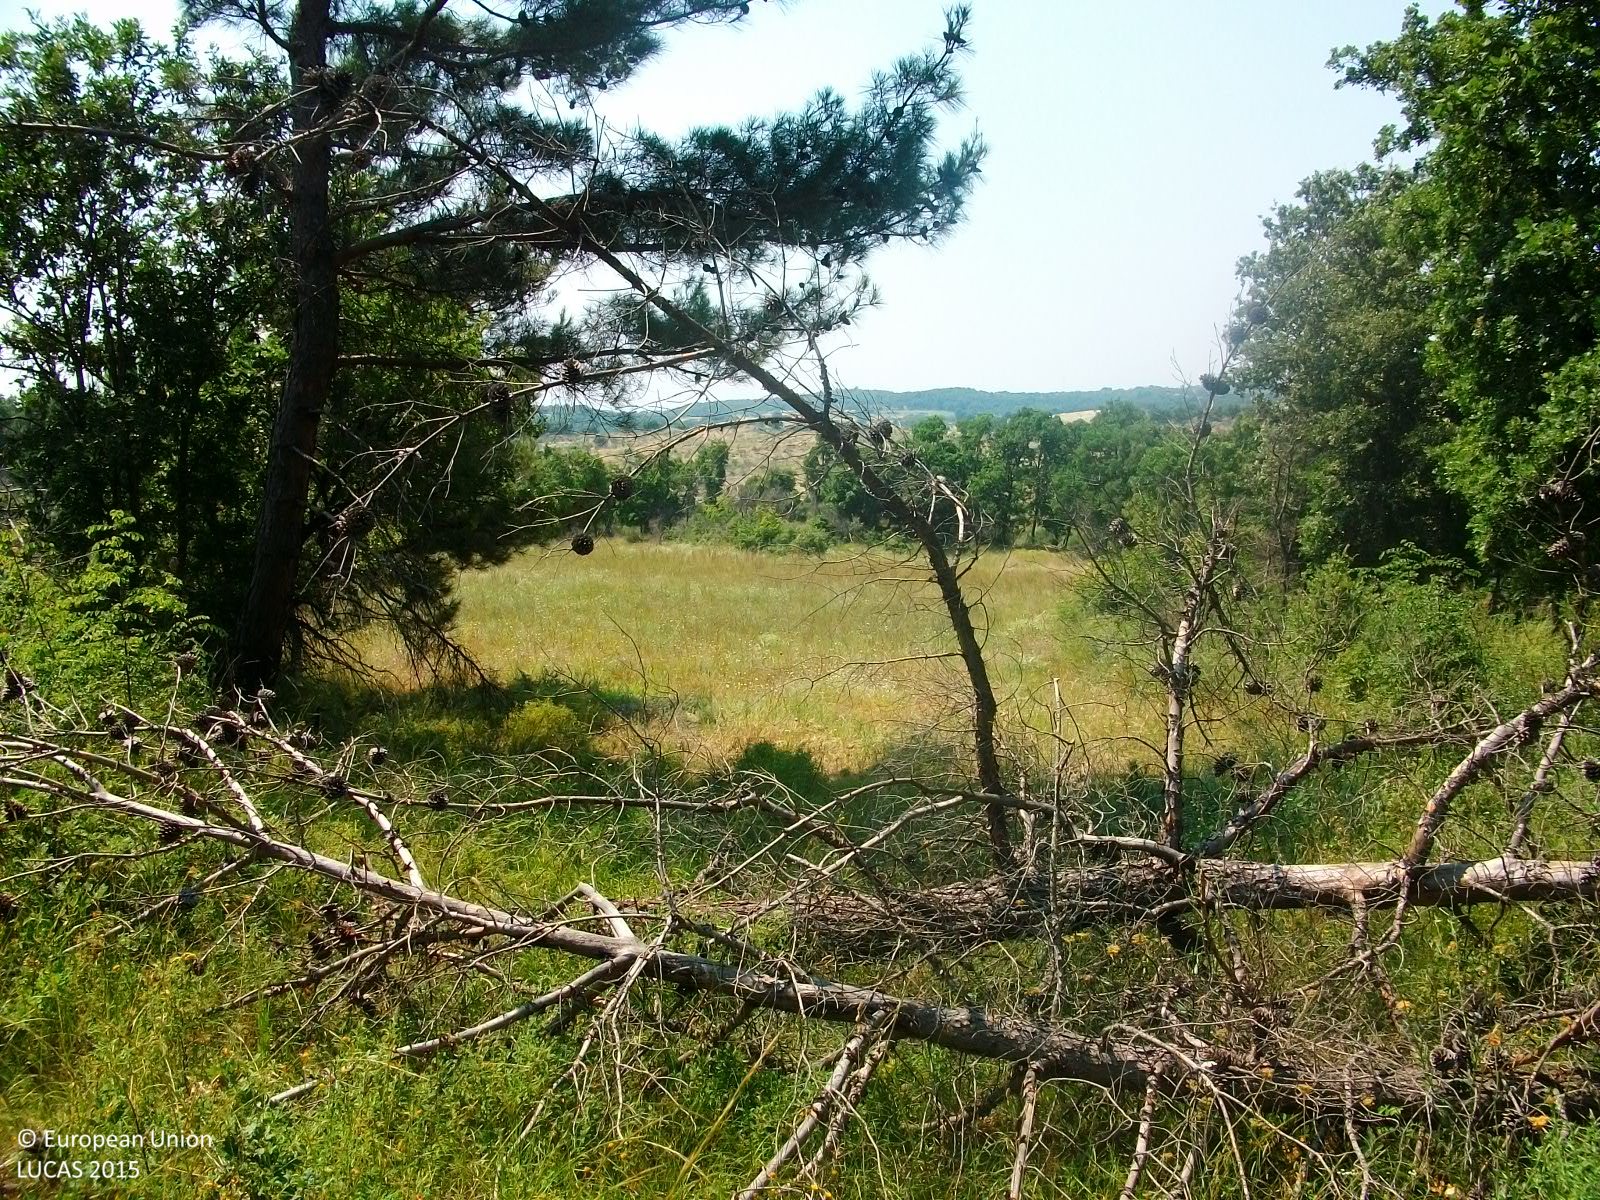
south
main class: Woodland
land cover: Broadleaved woodland
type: thermophilous deciduous forest
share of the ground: > 75 %
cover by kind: broadleaved forest trees 55 %, herbaceous plants 30 %, shrubs 10 %, coniferous forest trees 5 %
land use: Forestry
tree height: > 5 m
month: July
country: GR
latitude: 40.9850
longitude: 26.1208
